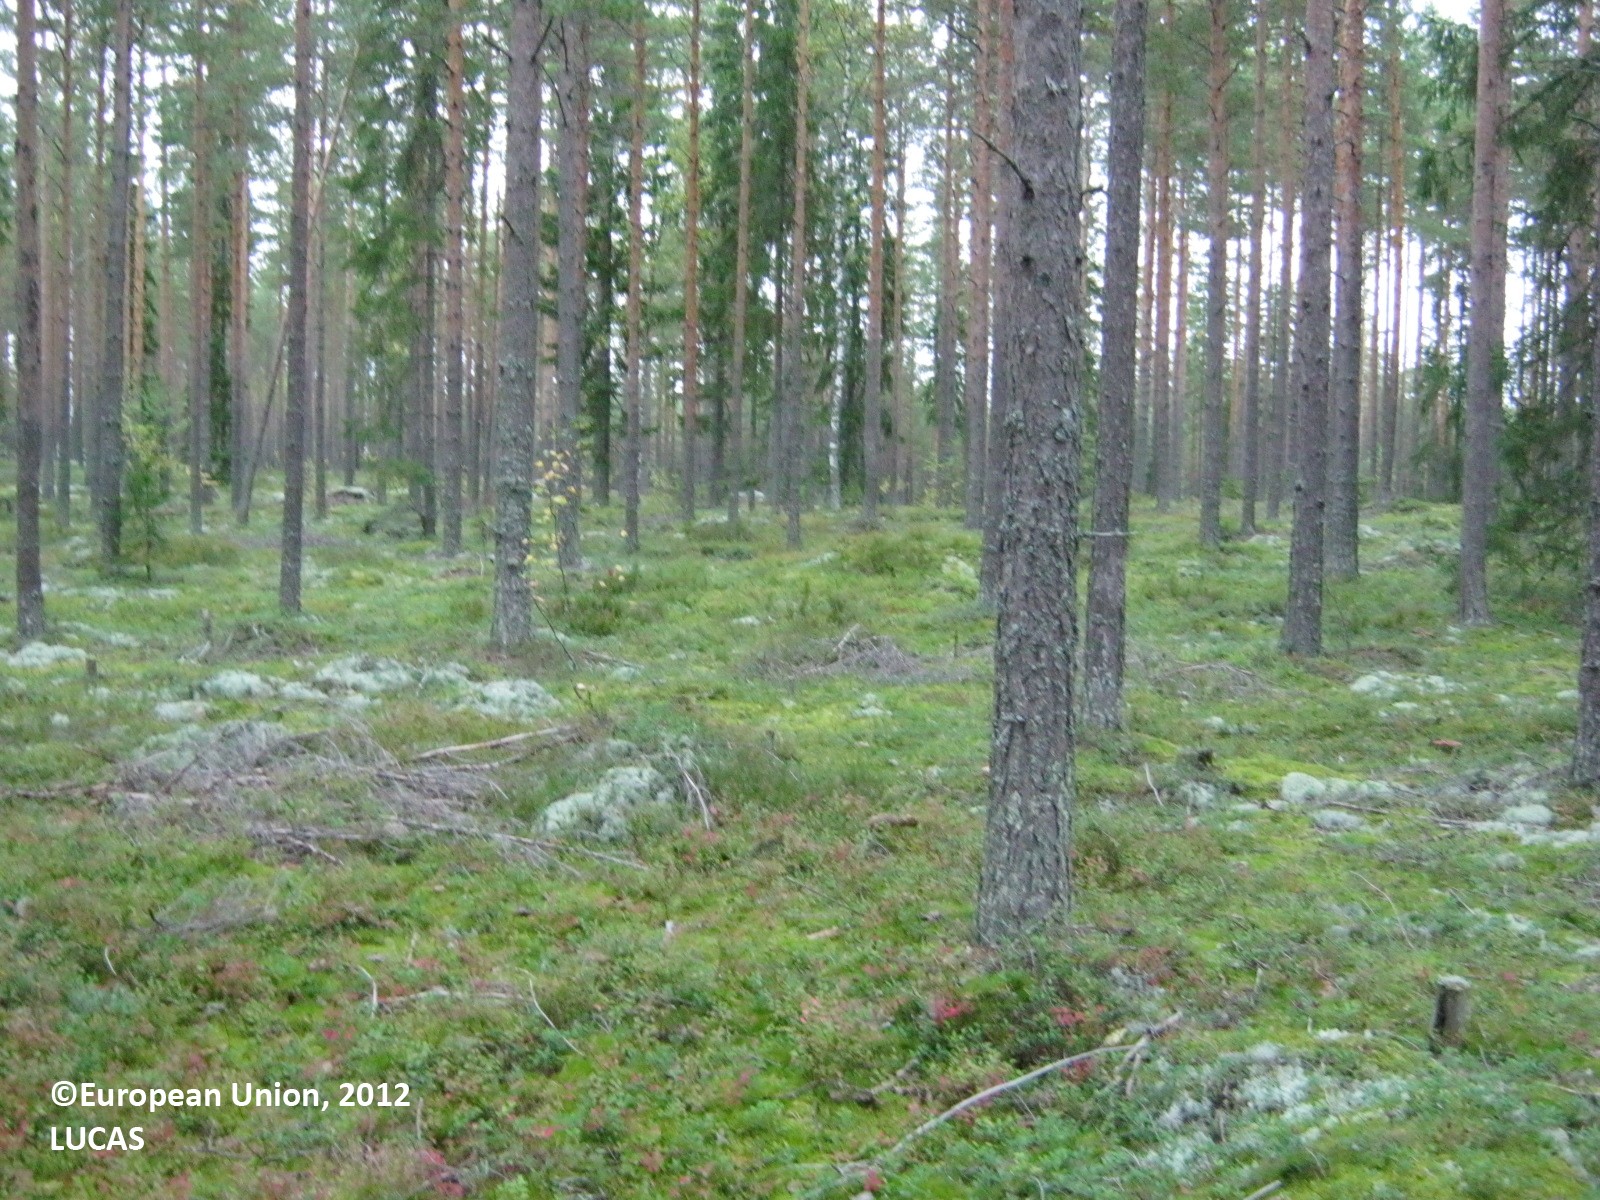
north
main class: Woodland
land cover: Other coniferous woodland
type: boreal forest
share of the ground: > 75 %
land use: Forestry
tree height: > 5 m
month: September
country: FI
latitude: 60.7365
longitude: 27.8192
